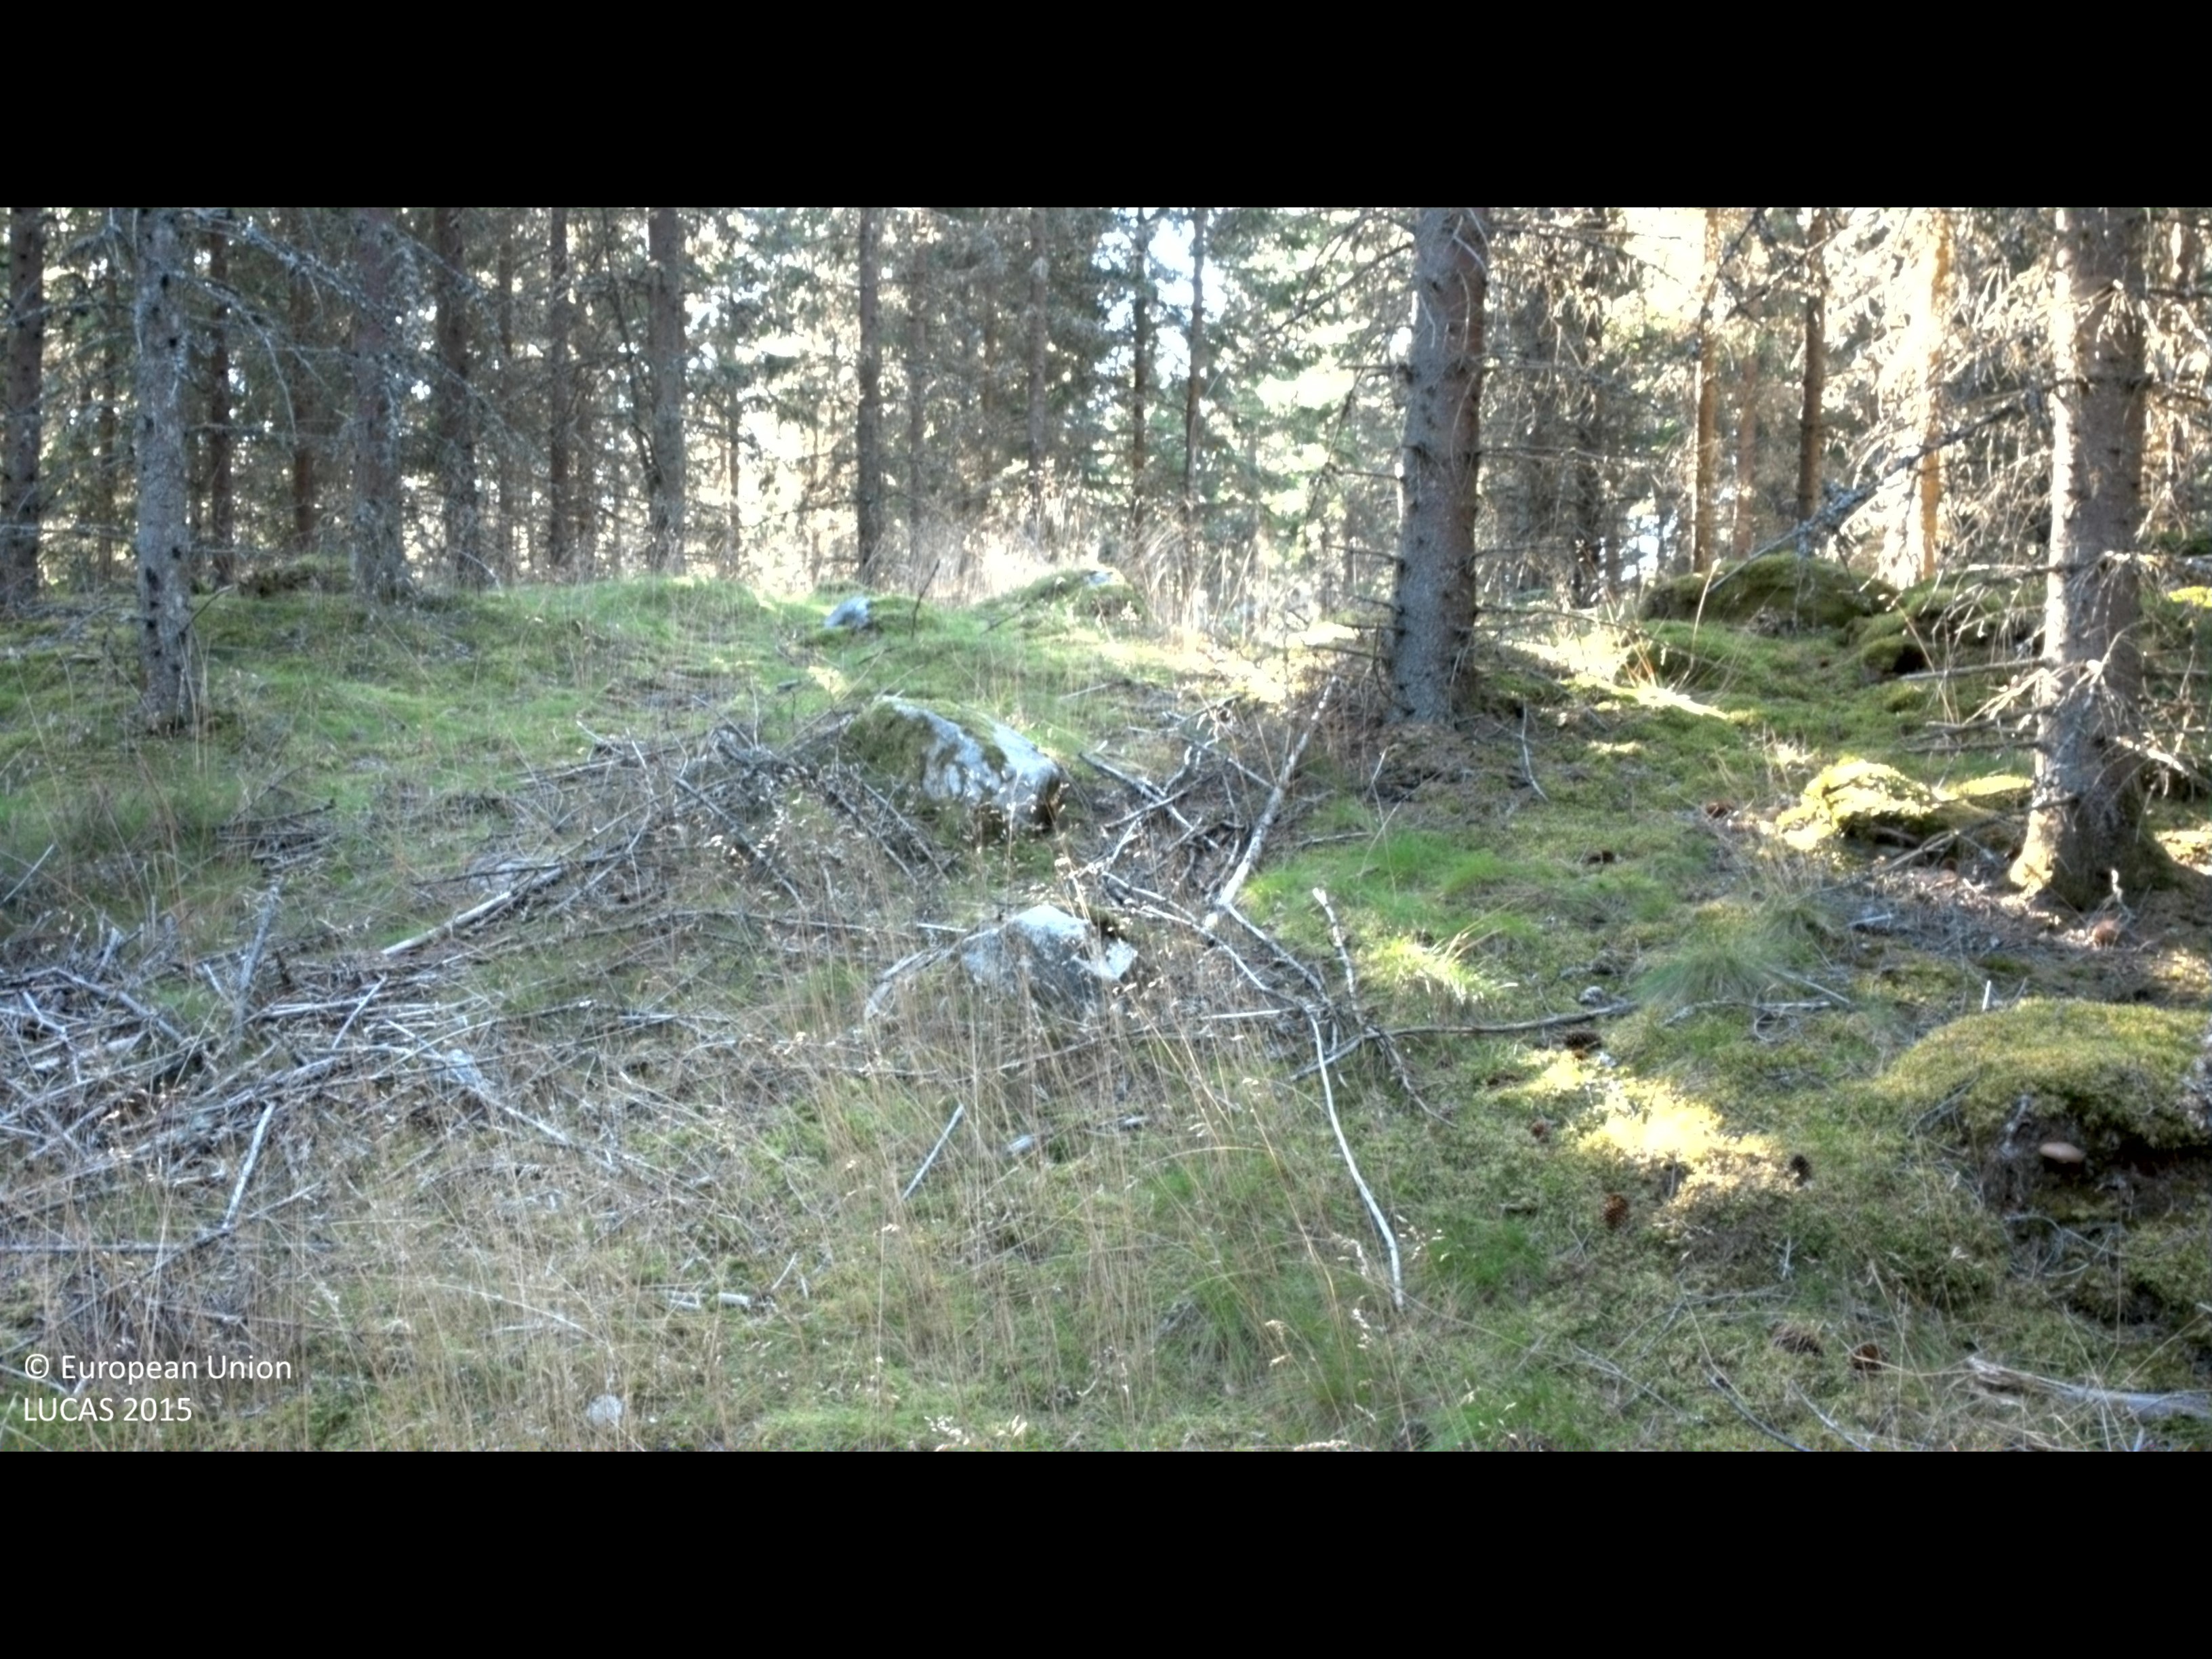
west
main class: Woodland
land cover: Spruce dominated coniferous woodland
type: boreal forest
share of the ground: > 75 %
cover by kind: coniferous forest trees 85 %, lichens and mosses 10 %, herbaceous plants 5 %
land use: Forestry
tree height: > 5 m
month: August
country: SE
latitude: 56.8200
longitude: 14.2401
